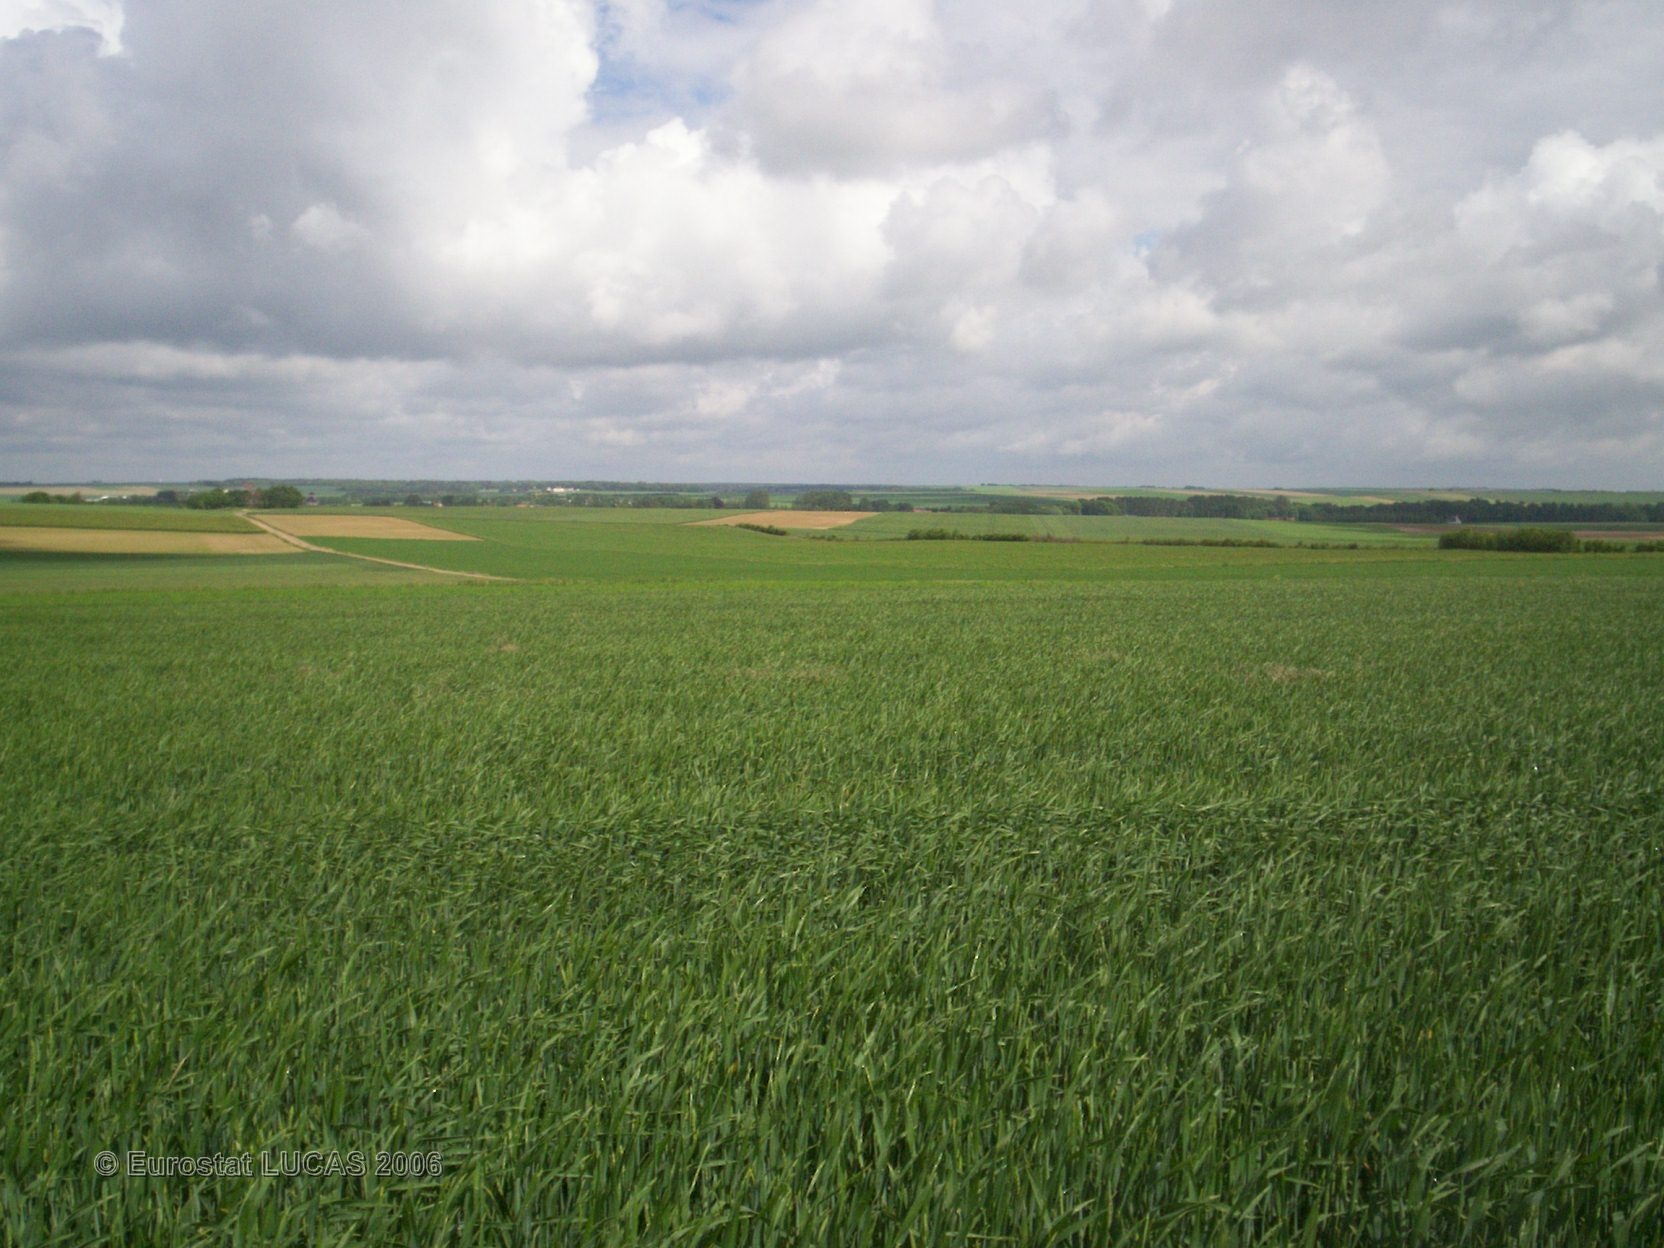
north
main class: Cropland
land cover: Common wheat
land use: Agriculture (excluding fallow land and kitchen gardens)
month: May
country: FR
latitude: 49.3791
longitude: 4.3900
